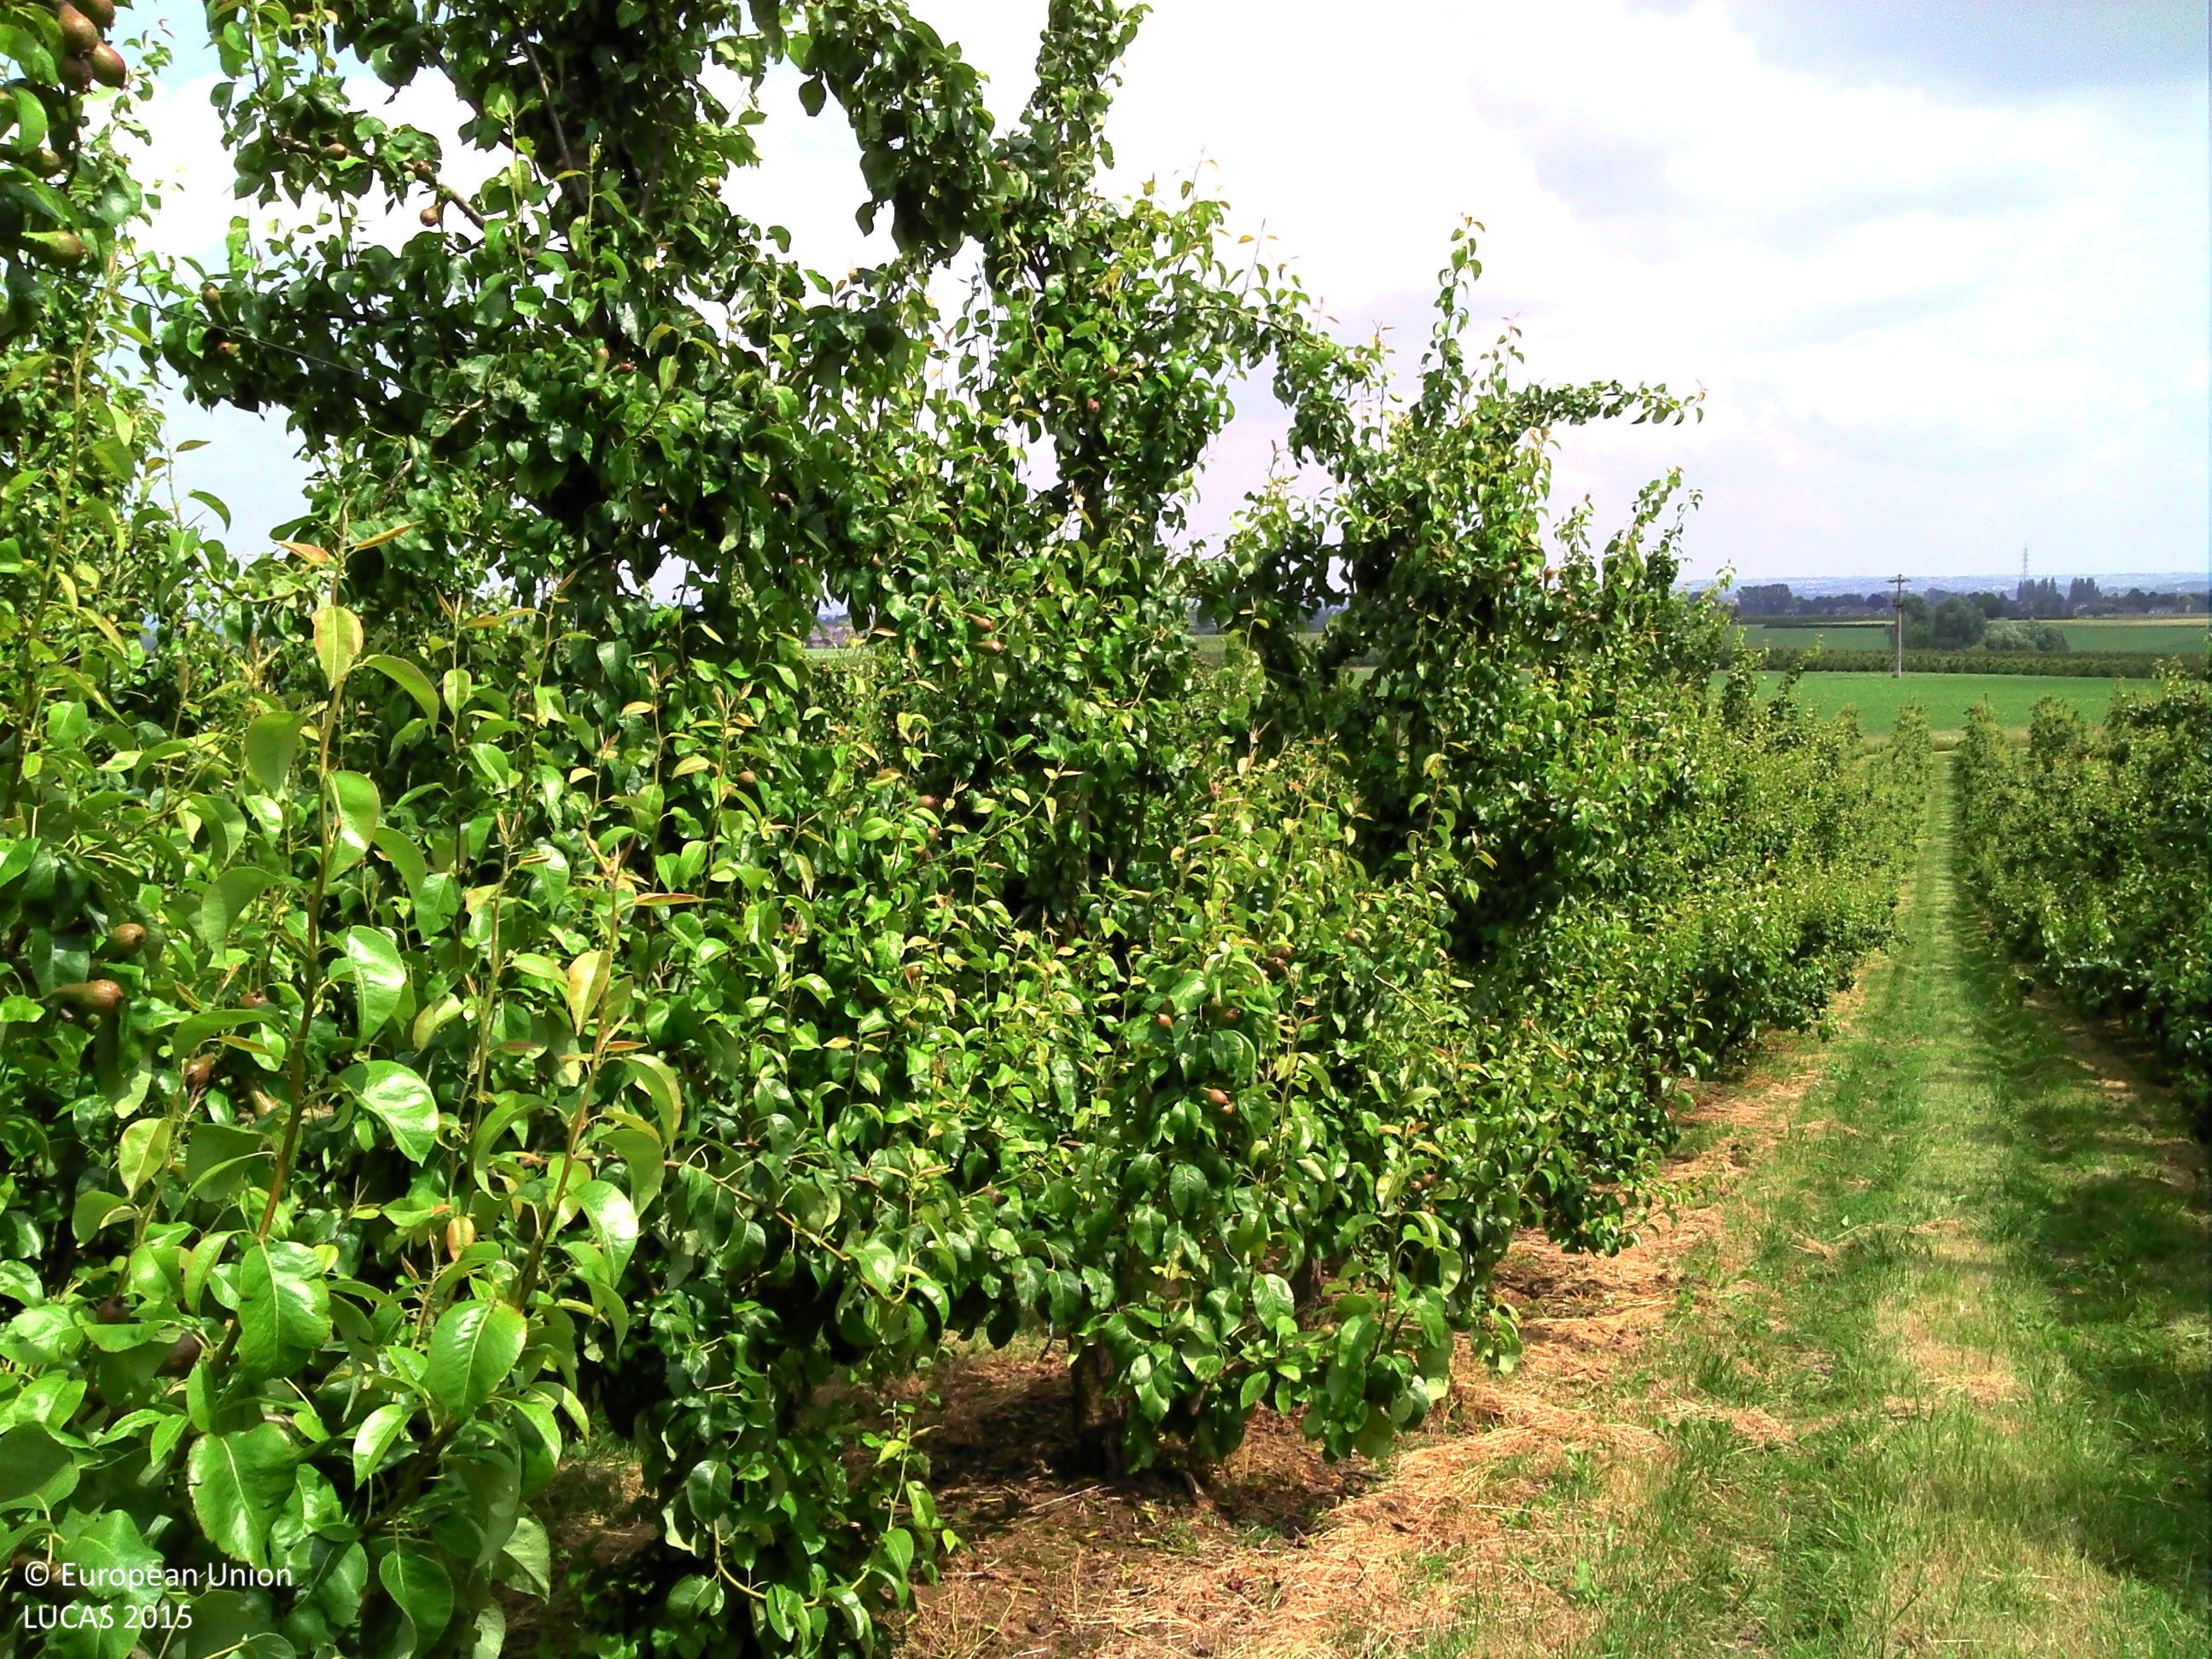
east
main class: Cropland
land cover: Pear fruit
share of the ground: 50 - 75 %
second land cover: Grassland without tree/shrub cover
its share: 25 - 50 %
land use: Agriculture (excluding fallow land and kitchen gardens)
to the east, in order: Pear fruit; Grassland without tree/shrub cover; Spontaneously vegetated surfaces; Tracks; Grass margins; Fences; Grassland without tree/shrub cover; Potatoes; Electric lines; Potatoes
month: June
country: BE
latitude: 50.7114
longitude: 5.5940
